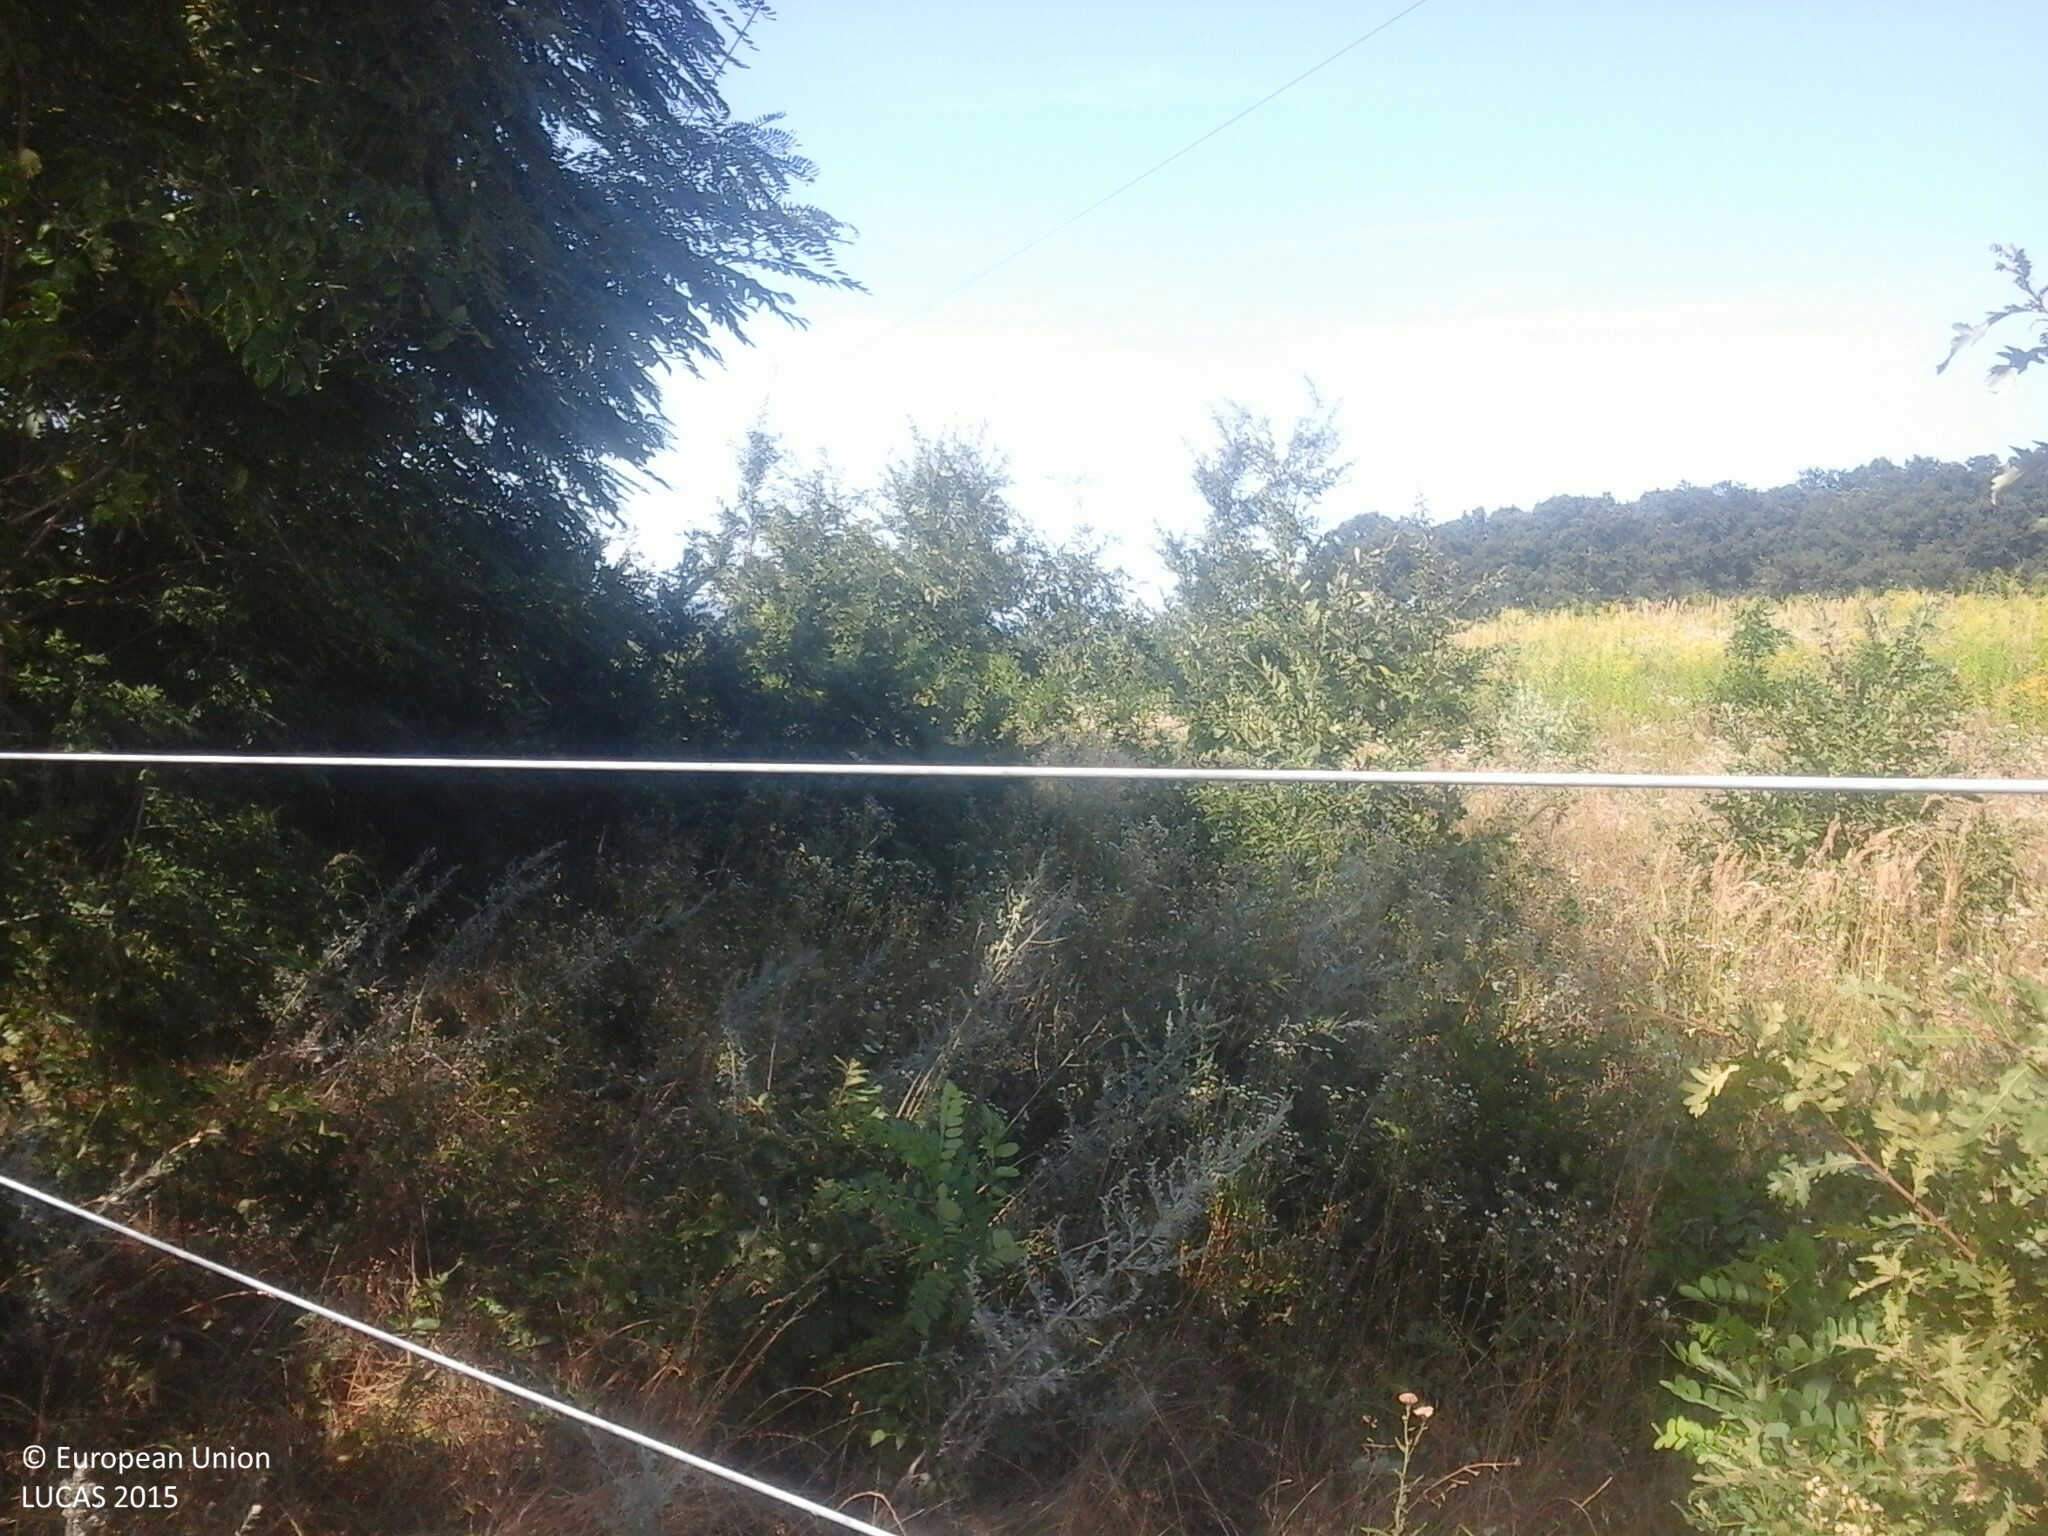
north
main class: Woodland
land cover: Broadleaved woodland
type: mesophytic deciduous forest
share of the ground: > 75 %
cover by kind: broadleaved forest trees 80 %, herbaceous plants 20 %
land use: Forestry
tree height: < 5 m
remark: Nursery
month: August
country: HU
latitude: 46.8535
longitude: 17.9168
